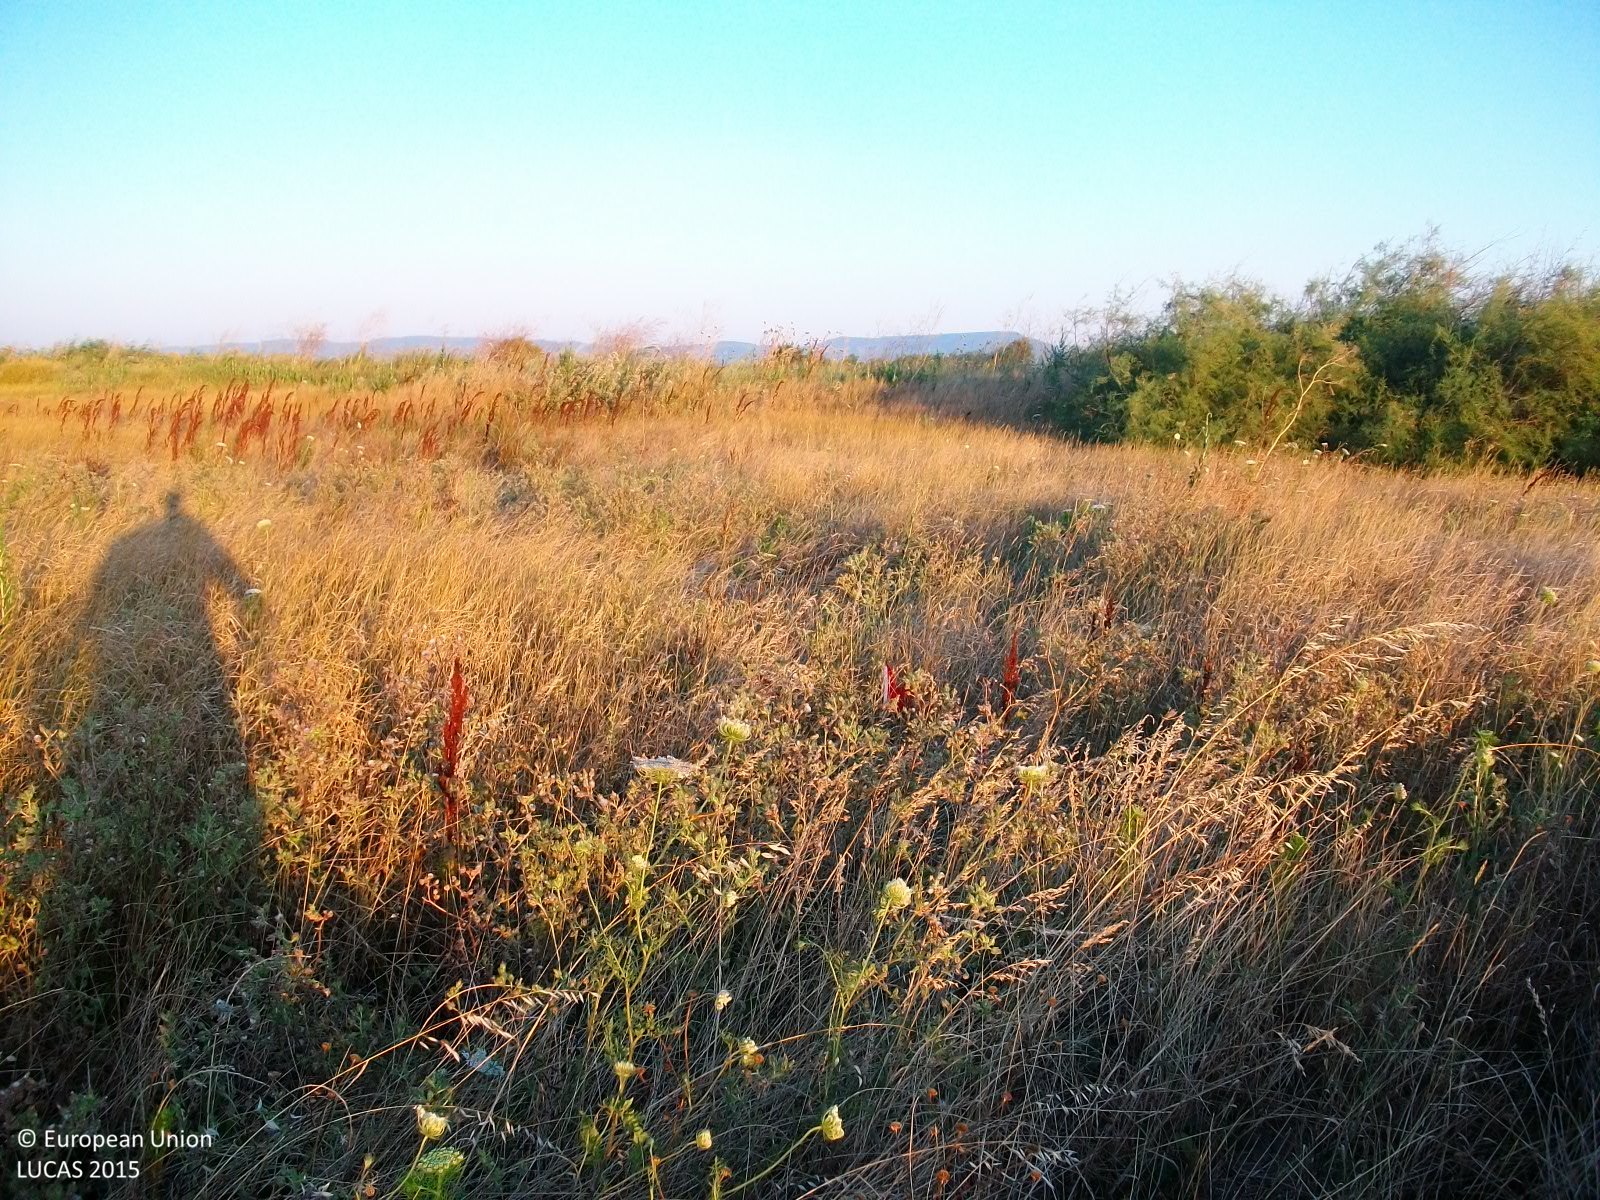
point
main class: Grassland
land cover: Spontaneously vegetated surfaces
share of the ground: > 75 %
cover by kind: herbaceous plants 100 %
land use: Fallow land
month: July
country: GR
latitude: 40.8264
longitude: 26.0793
